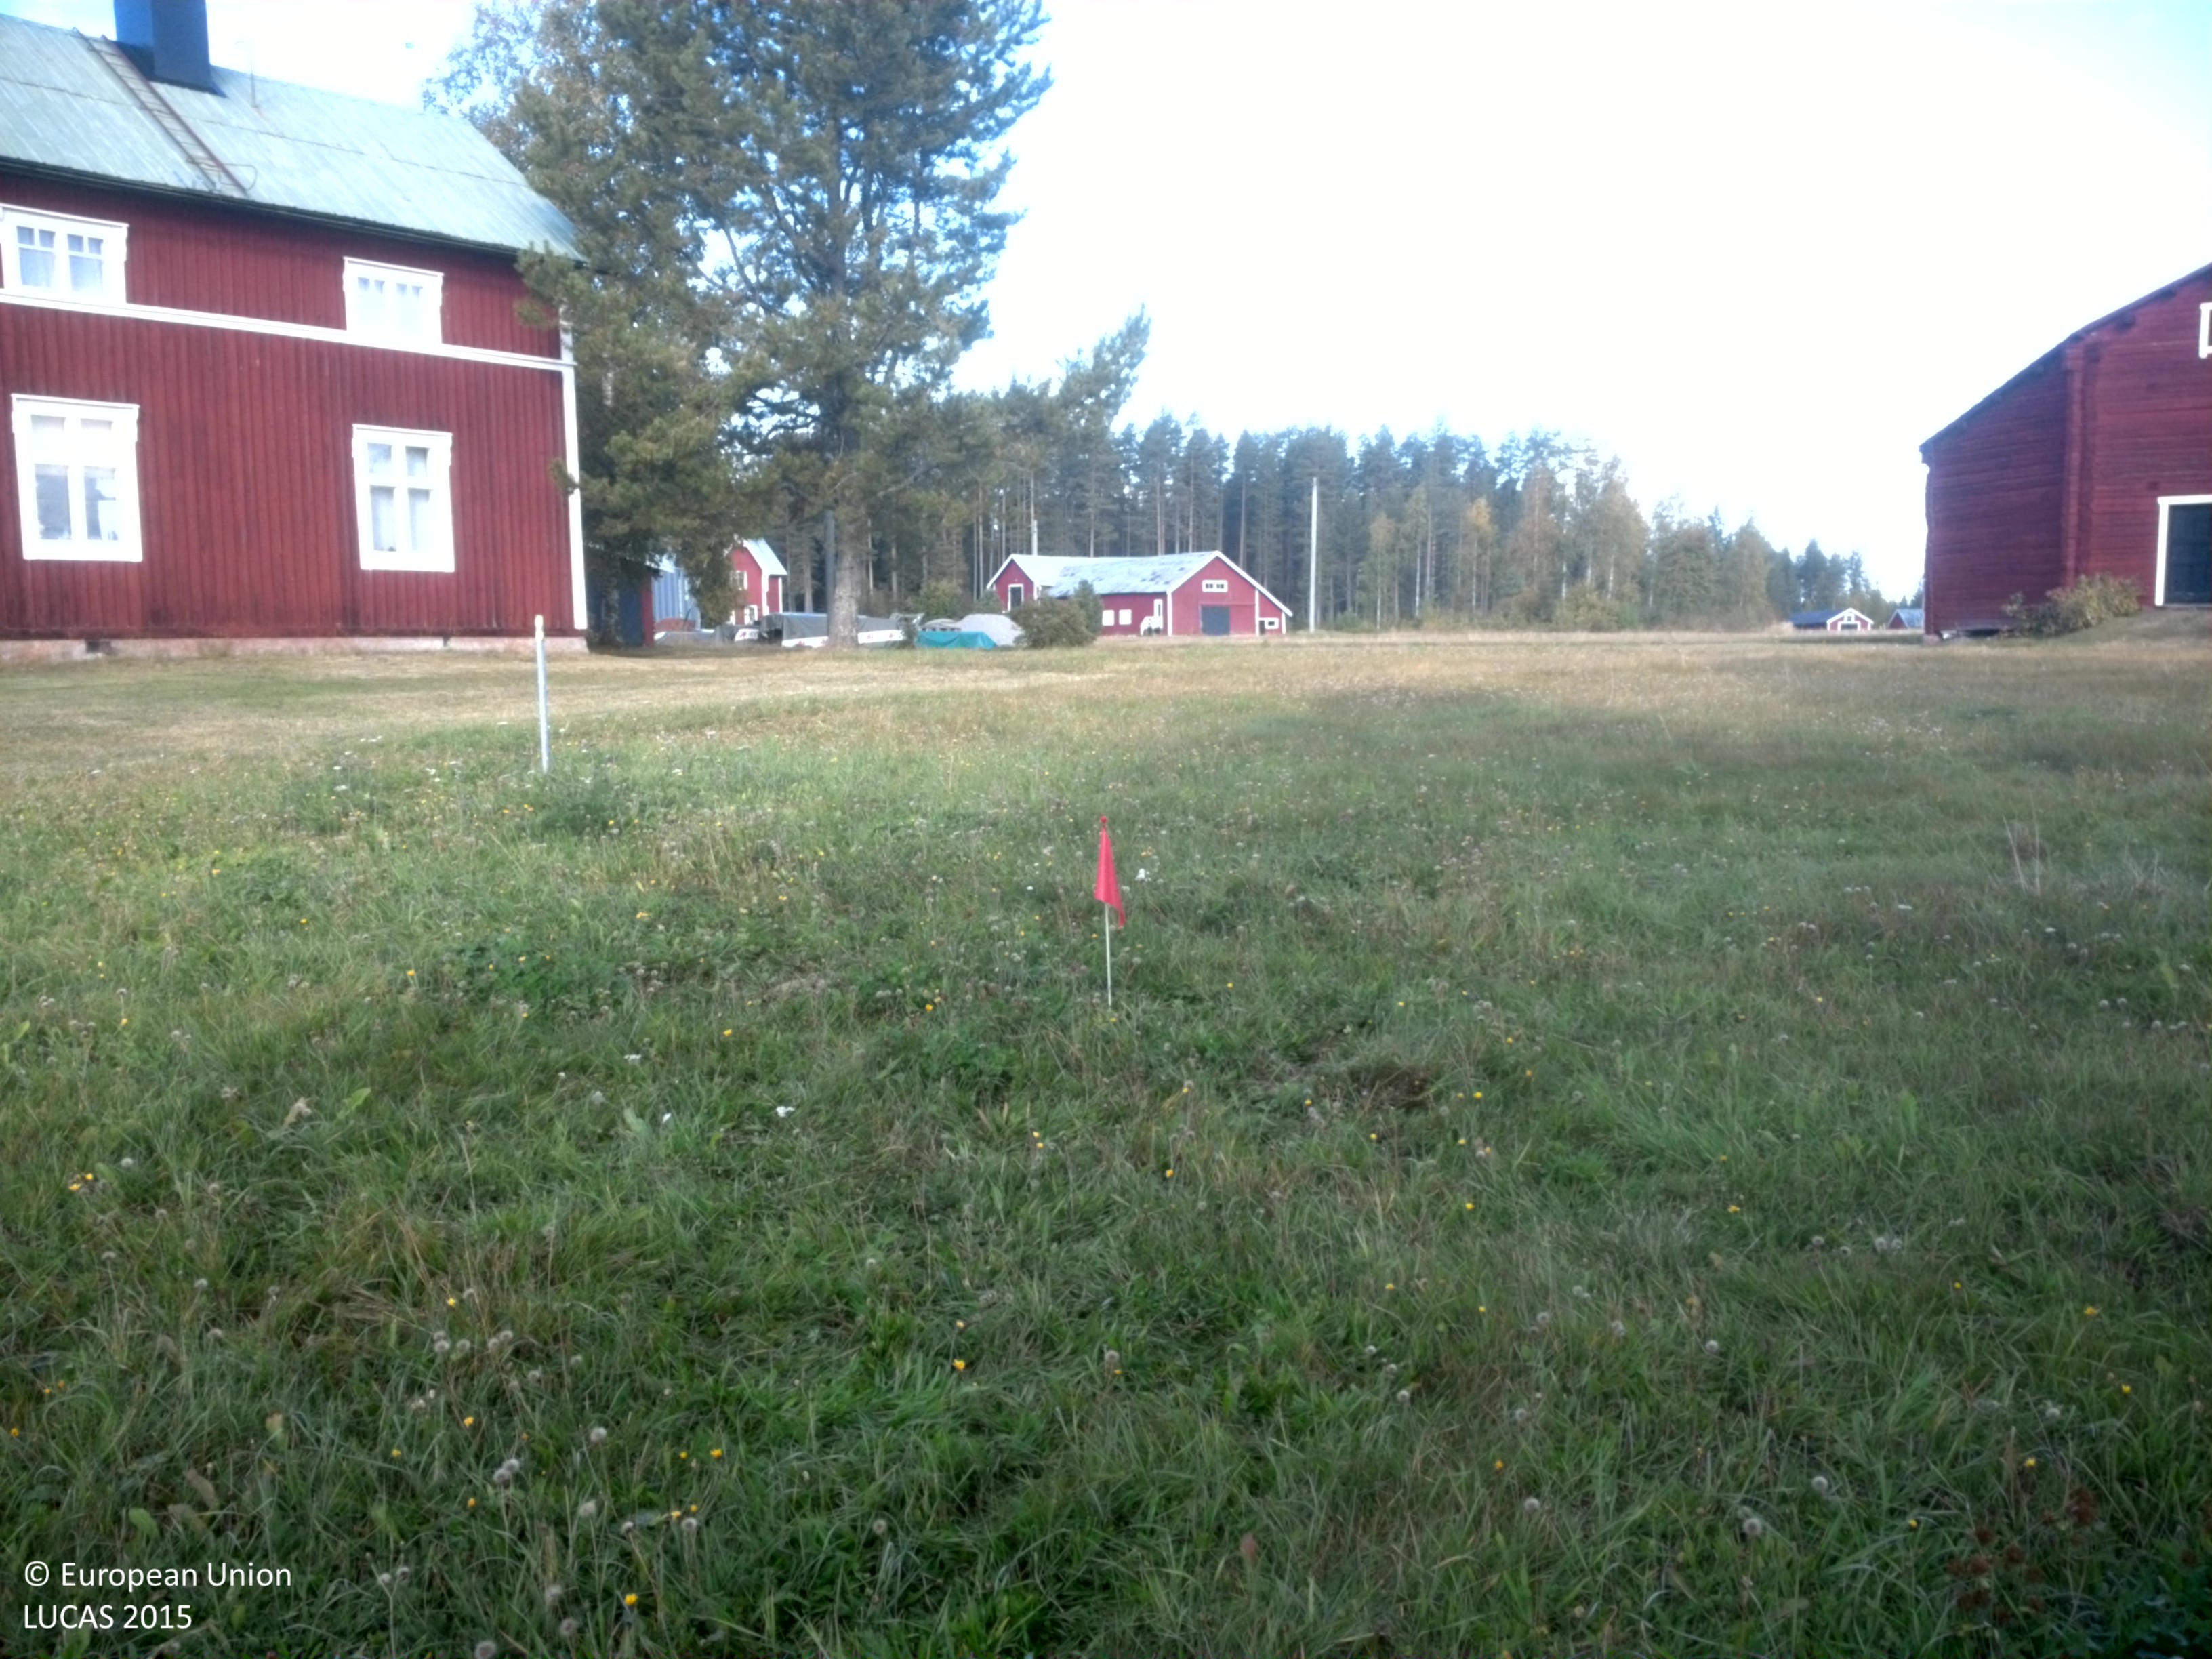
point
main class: Grassland
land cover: Grassland without tree/shrub cover
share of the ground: > 75 %
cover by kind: herbaceous plants 100 %
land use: Agriculture (excluding fallow land and kitchen gardens)
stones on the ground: 10 - 25 %
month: September
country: SE
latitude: 64.4332
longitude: 19.9220
